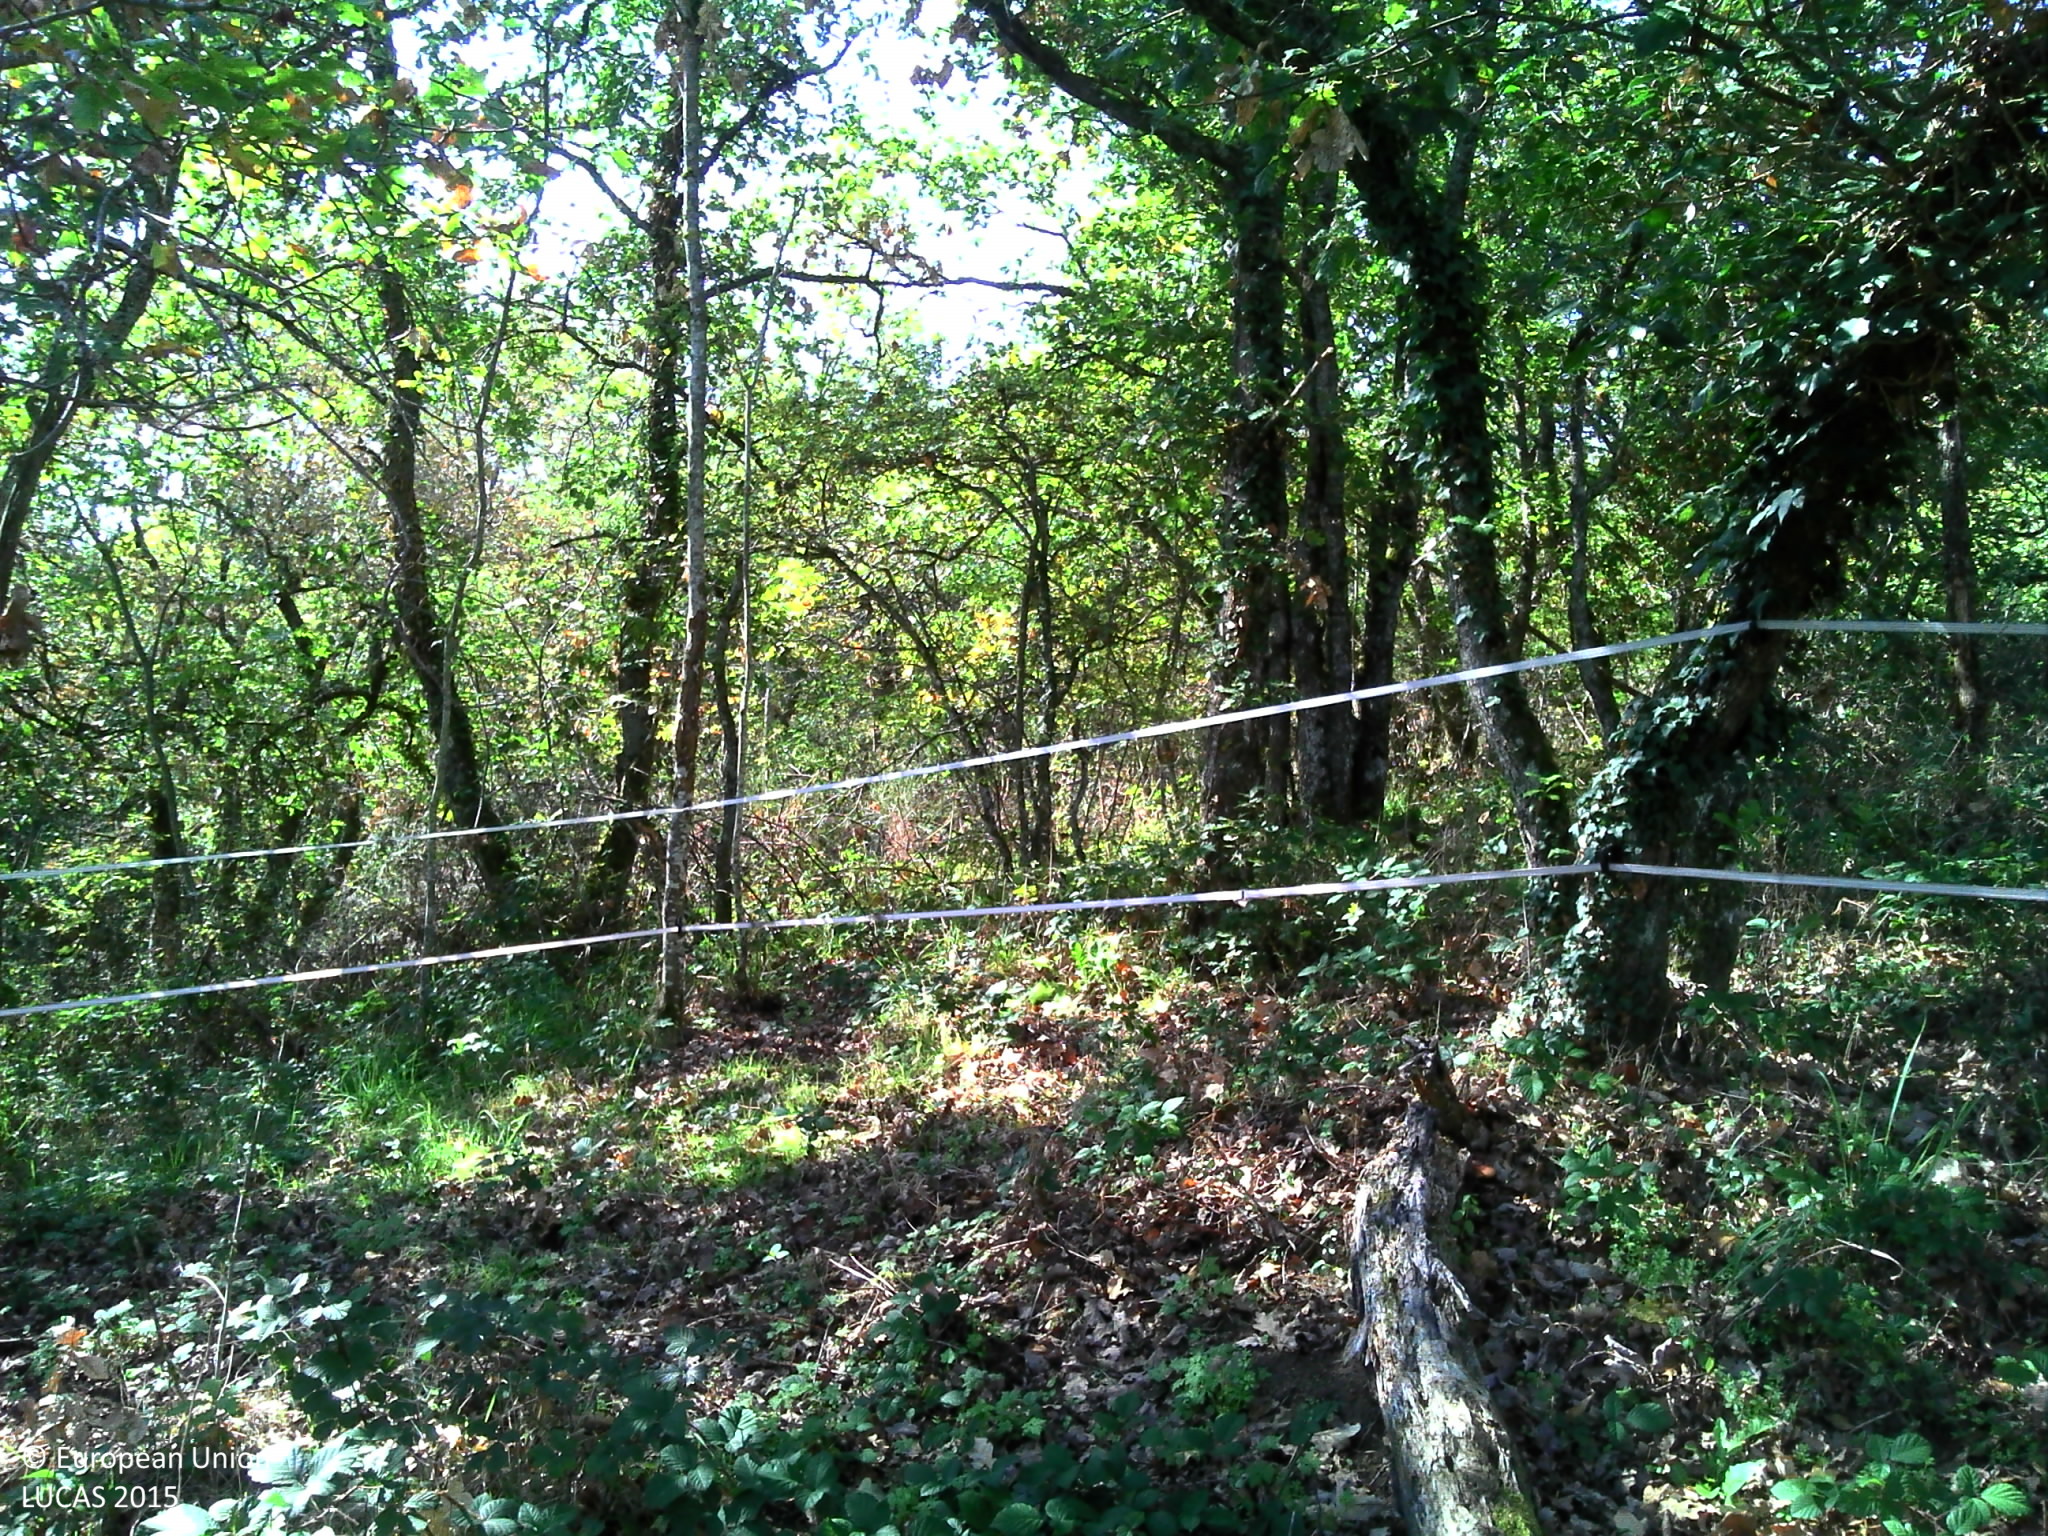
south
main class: Woodland
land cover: Broadleaved woodland
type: acidophilous oak and oak-birch forest
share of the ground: 50 - 75 %
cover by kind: broadleaved forest trees 65 %, herbaceous plants 35 %
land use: Forestry
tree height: < 5 m
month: October
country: FR
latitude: 45.8527
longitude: 3.0321
